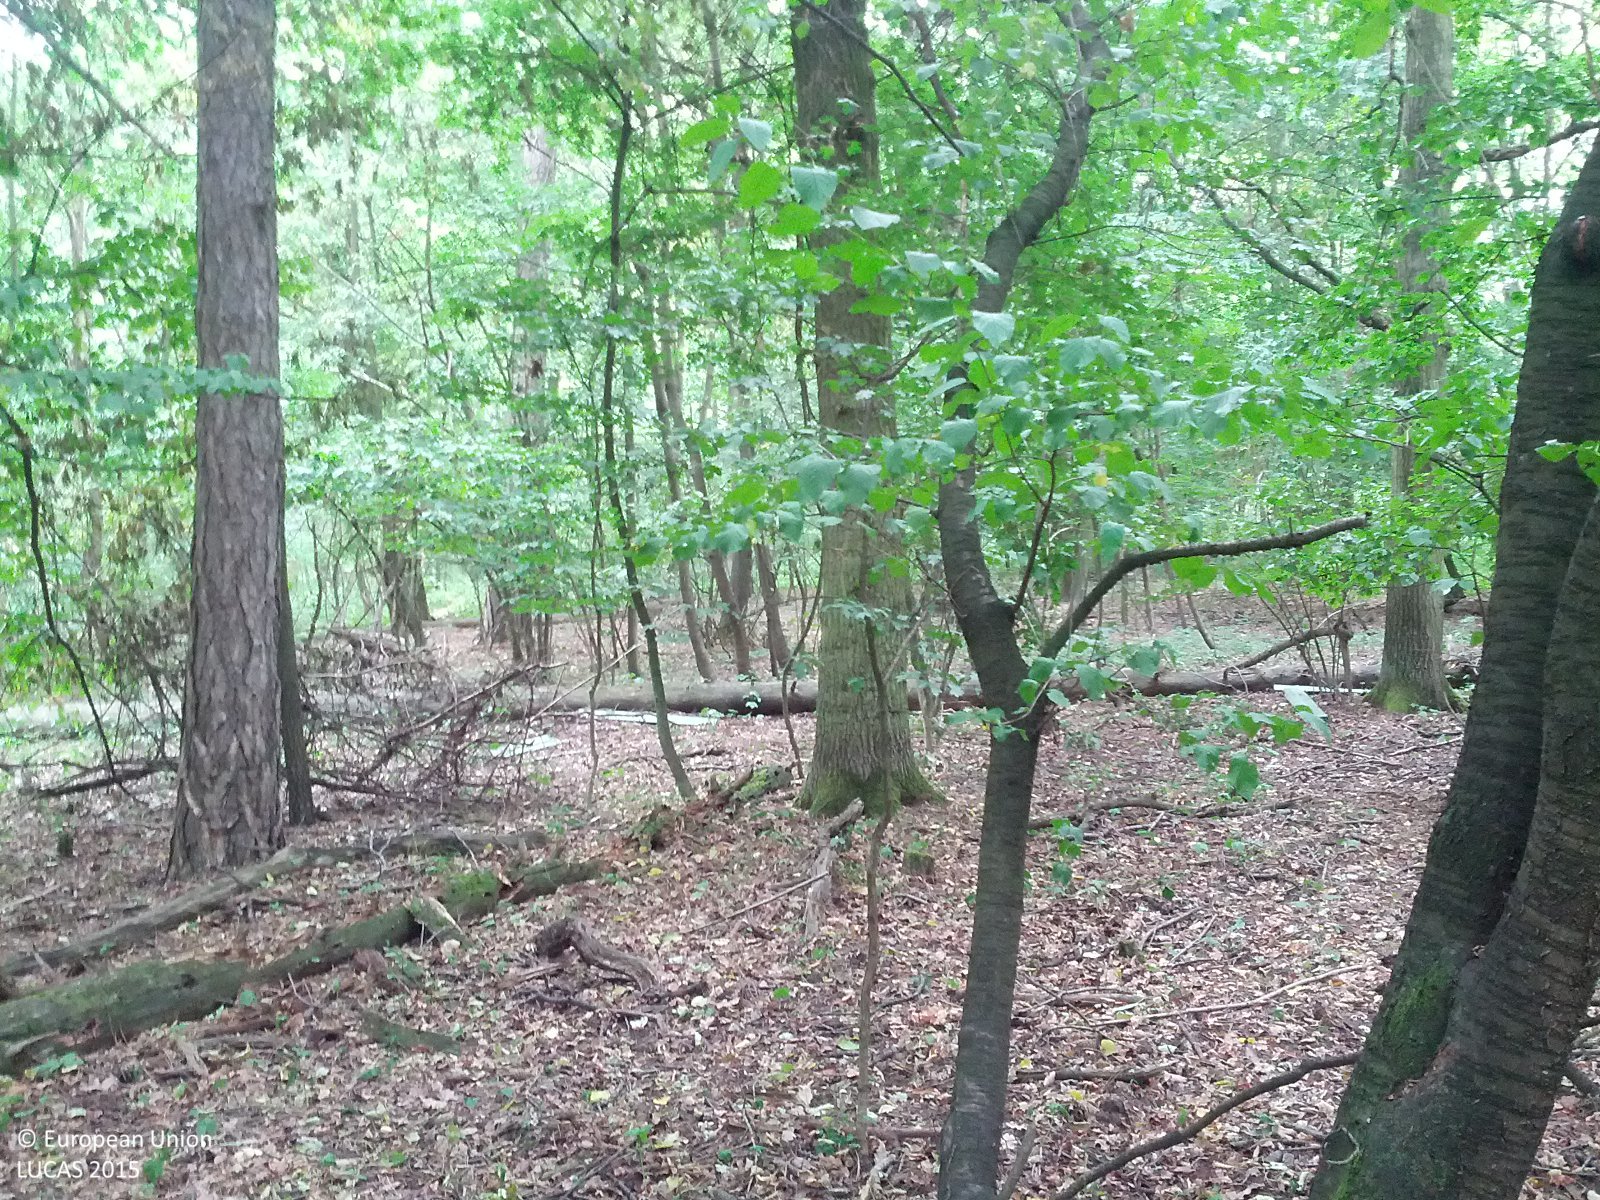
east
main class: Woodland
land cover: Broadleaved woodland
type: hemiboreal forest and nemoral coniferous forest and mixed broadleaved-coniferous forest
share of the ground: > 75 %
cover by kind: broadleaved forest trees 95 %, herbaceous plants 5 %
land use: Forestry
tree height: > 5 m
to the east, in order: Broadleaved woodland; Tracks; Broadleaved woodland
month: July
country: AT
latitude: 48.4658
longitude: 16.4842
